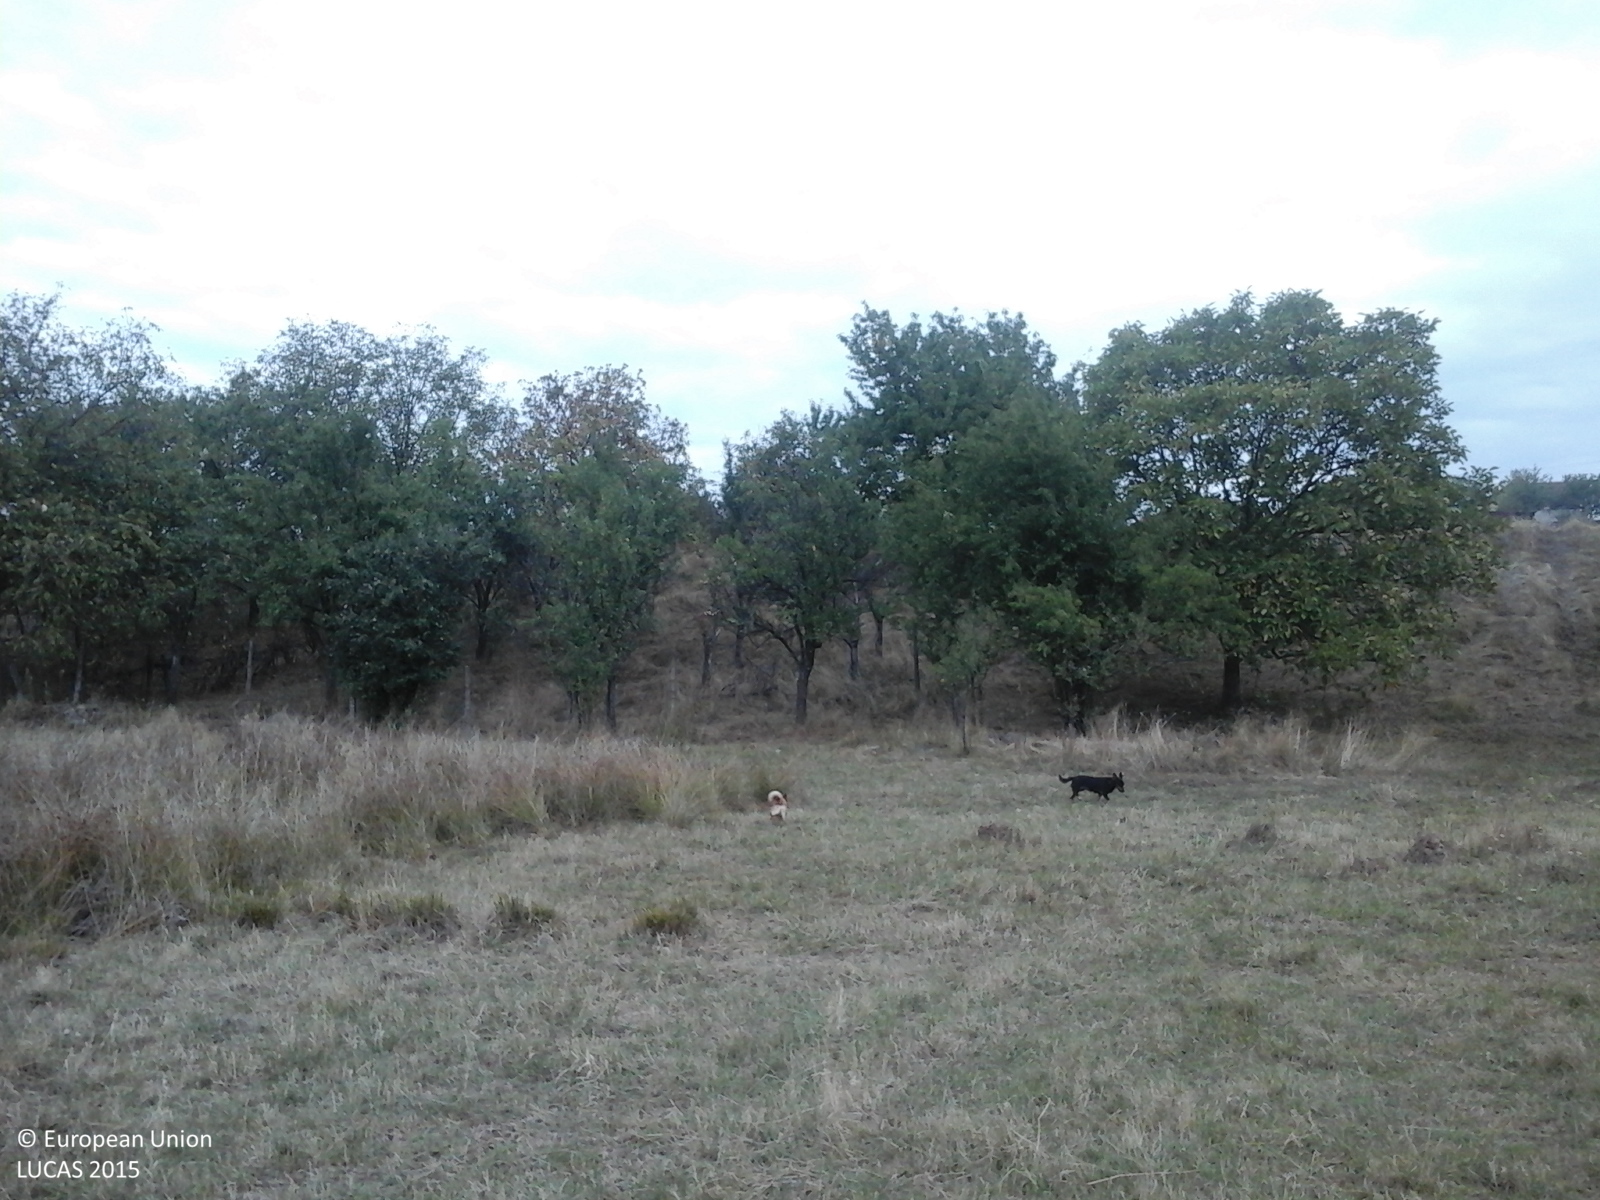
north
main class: Grassland
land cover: Grassland without tree/shrub cover
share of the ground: > 75 %
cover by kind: herbaceous plants 100 %
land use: Agriculture (excluding fallow land and kitchen gardens)
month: September
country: RO
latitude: 47.8536
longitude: 23.4260
